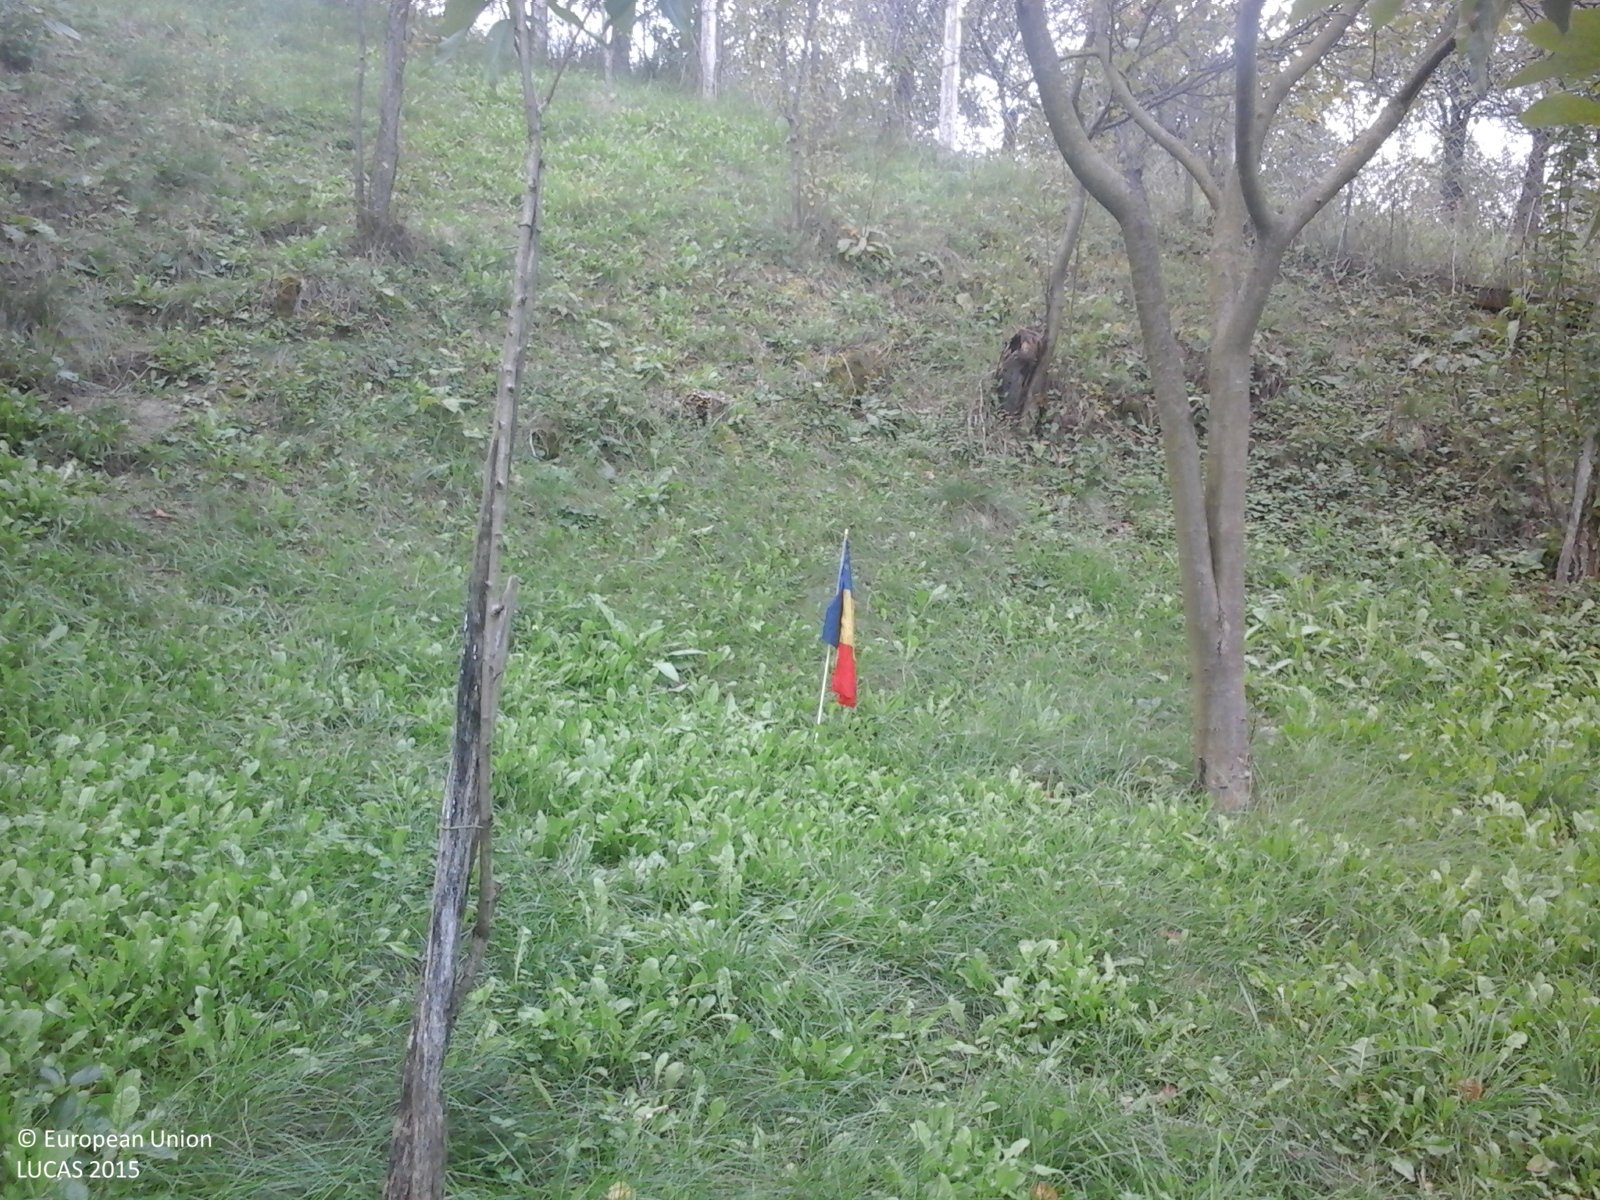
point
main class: Cropland
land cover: Nuts trees
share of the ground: > 75 %
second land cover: Grassland without tree/shrub cover
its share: > 75 %
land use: Agriculture (excluding fallow land and kitchen gardens)
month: October
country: RO
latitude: 46.1665
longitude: 23.4960
